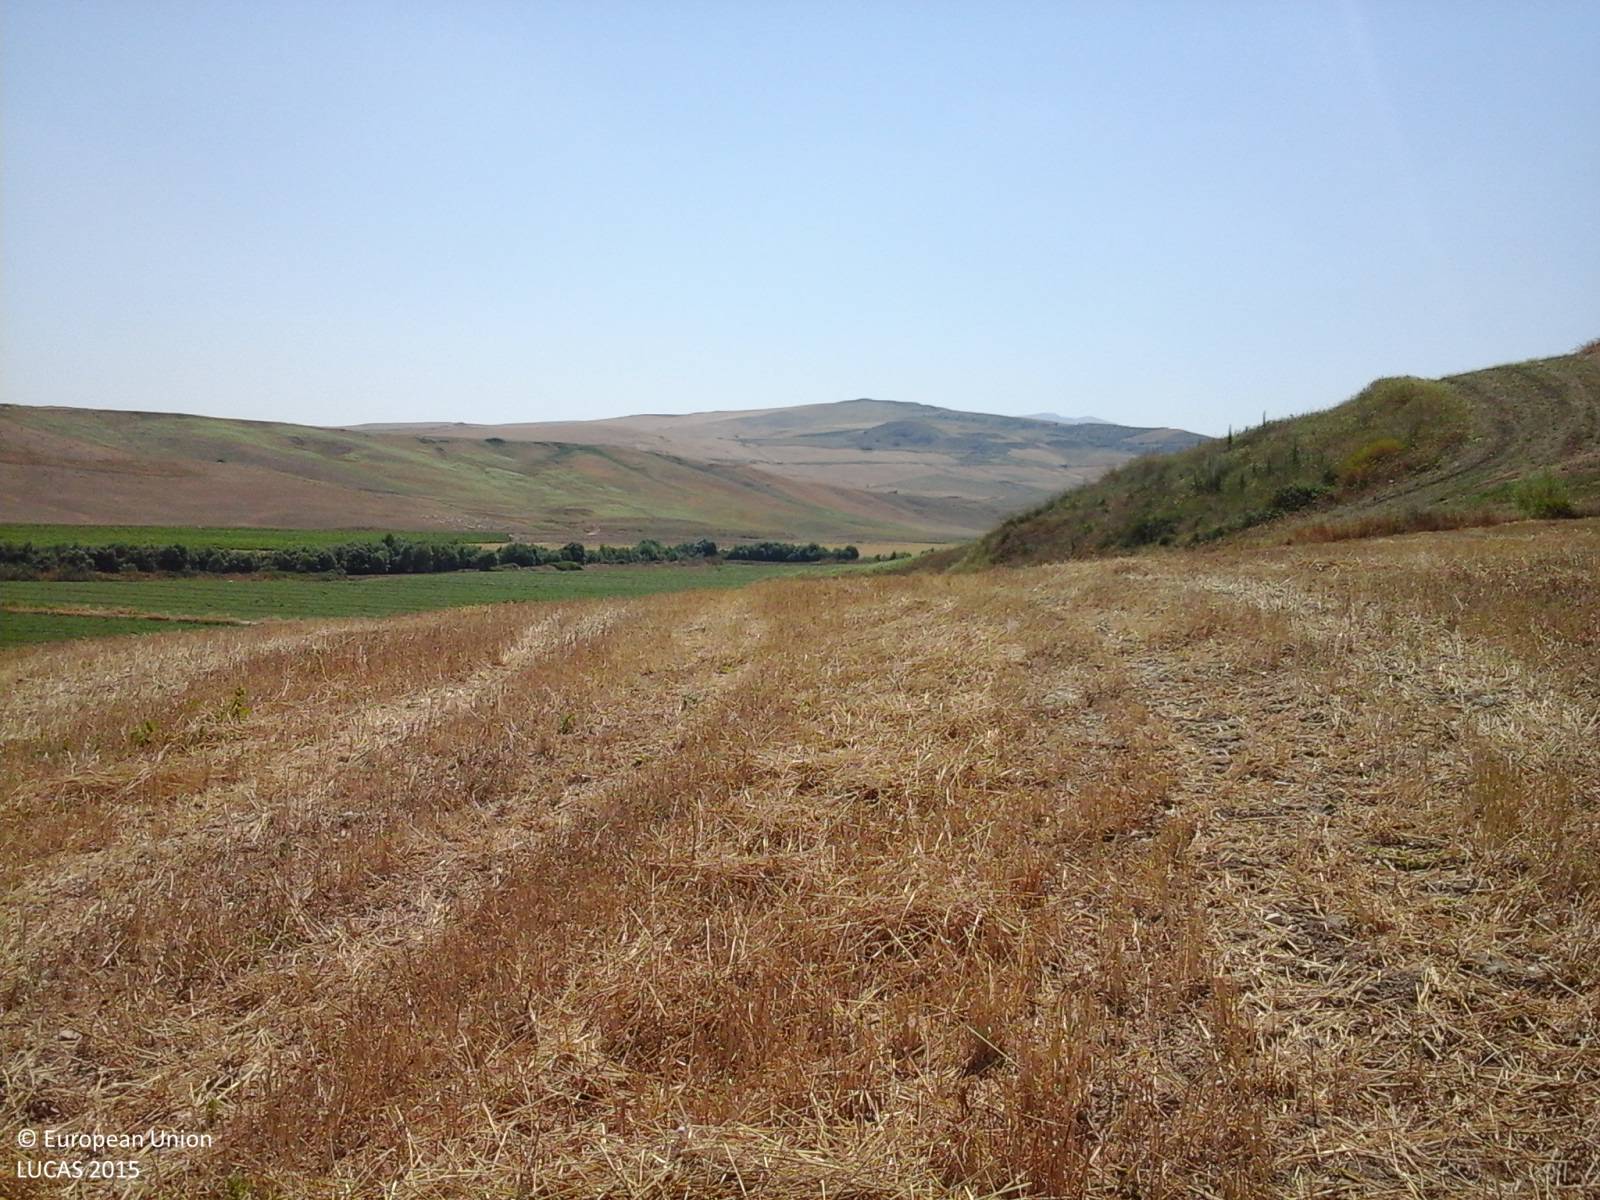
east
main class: Cropland
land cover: Durum wheat
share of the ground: > 75 %
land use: Agriculture (excluding fallow land and kitchen gardens)
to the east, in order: Durum wheat; Grassland without tree/shrub cover; Durum wheat; Grassland without tree/shrub cover; Other fresh vegetables; Grass margins; Tracks; Grass margins; Other fresh vegetables
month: July
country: IT
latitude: 37.8038
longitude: 13.1682
